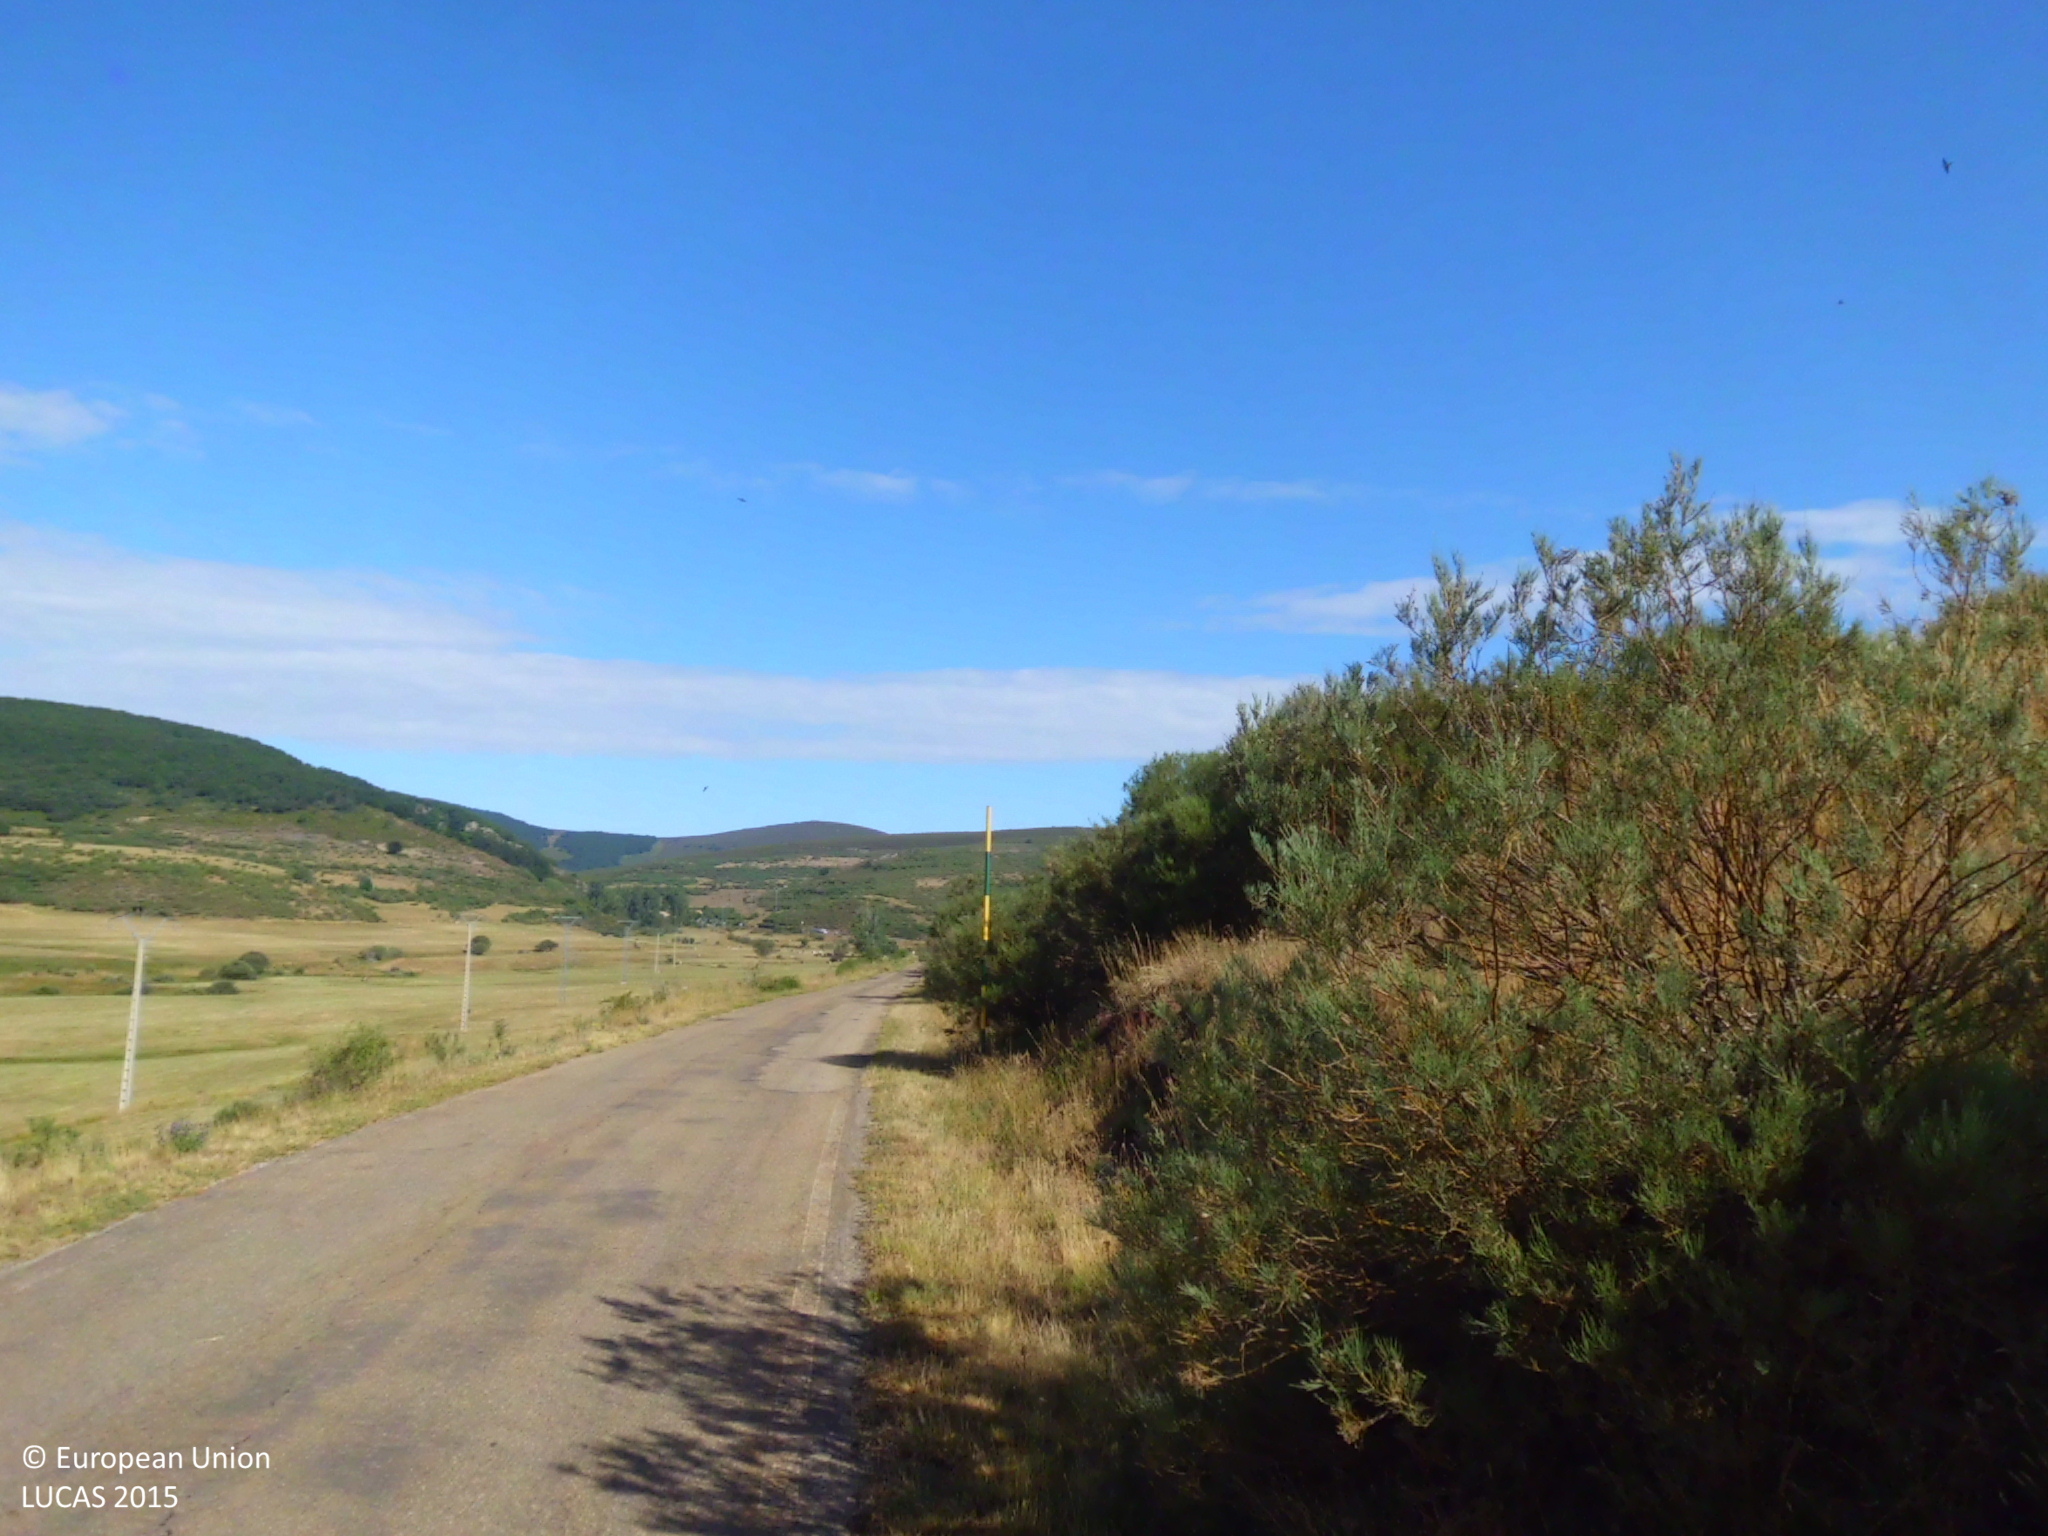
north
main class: Shrubland
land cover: Shrubland with sparse tree cover
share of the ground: > 75 %
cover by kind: shrubs 90 %, broadleaved forest trees 5 %, herbaceous plants 5 %
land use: Semi-natural and natural areas not in use
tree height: < 5 m
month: July
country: ES
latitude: 43.0148
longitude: -4.4980
